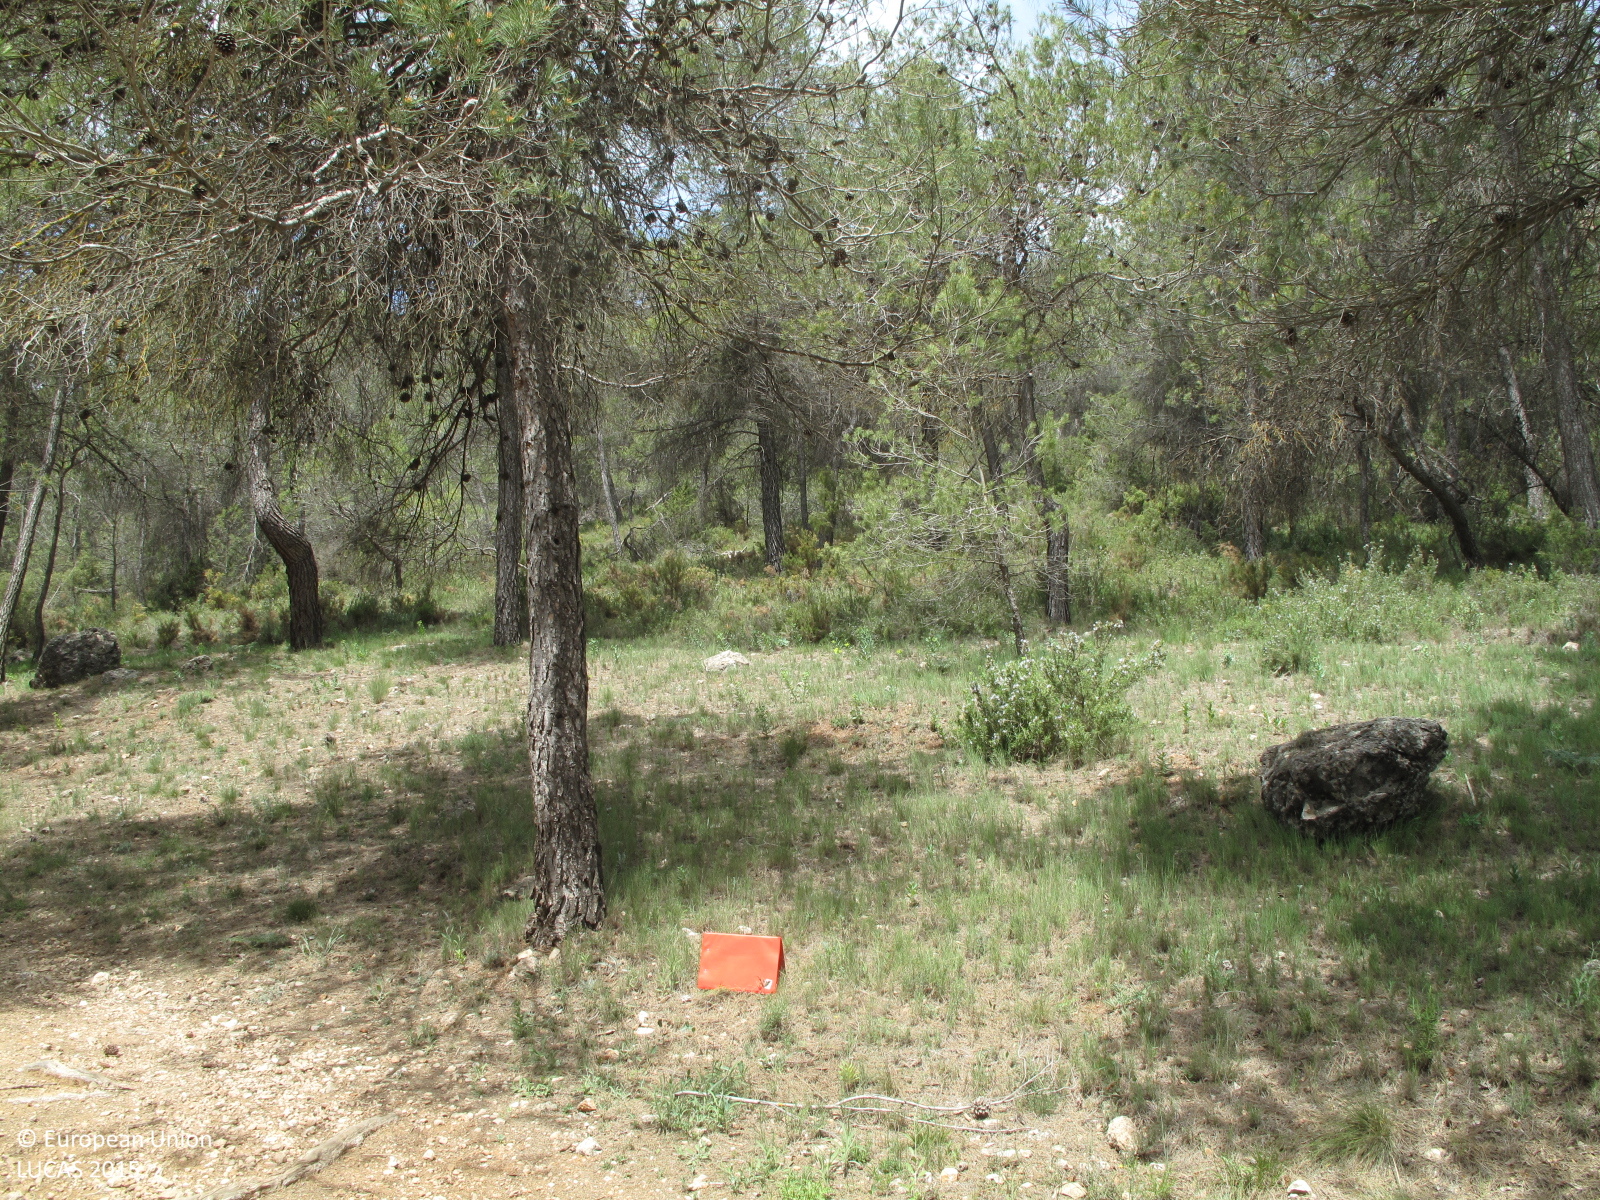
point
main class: Woodland
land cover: Pine dominated coniferous woodland
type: coniferous forest of the mediterranean region
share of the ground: 50 - 75 %
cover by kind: coniferous forest trees 50 %, consolidated bare surface 25 %, herbaceous plants 20 %, shrubs 5 %
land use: Semi-natural and natural areas not in use
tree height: > 5 m
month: May
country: ES
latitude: 38.7492
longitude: -0.5413
